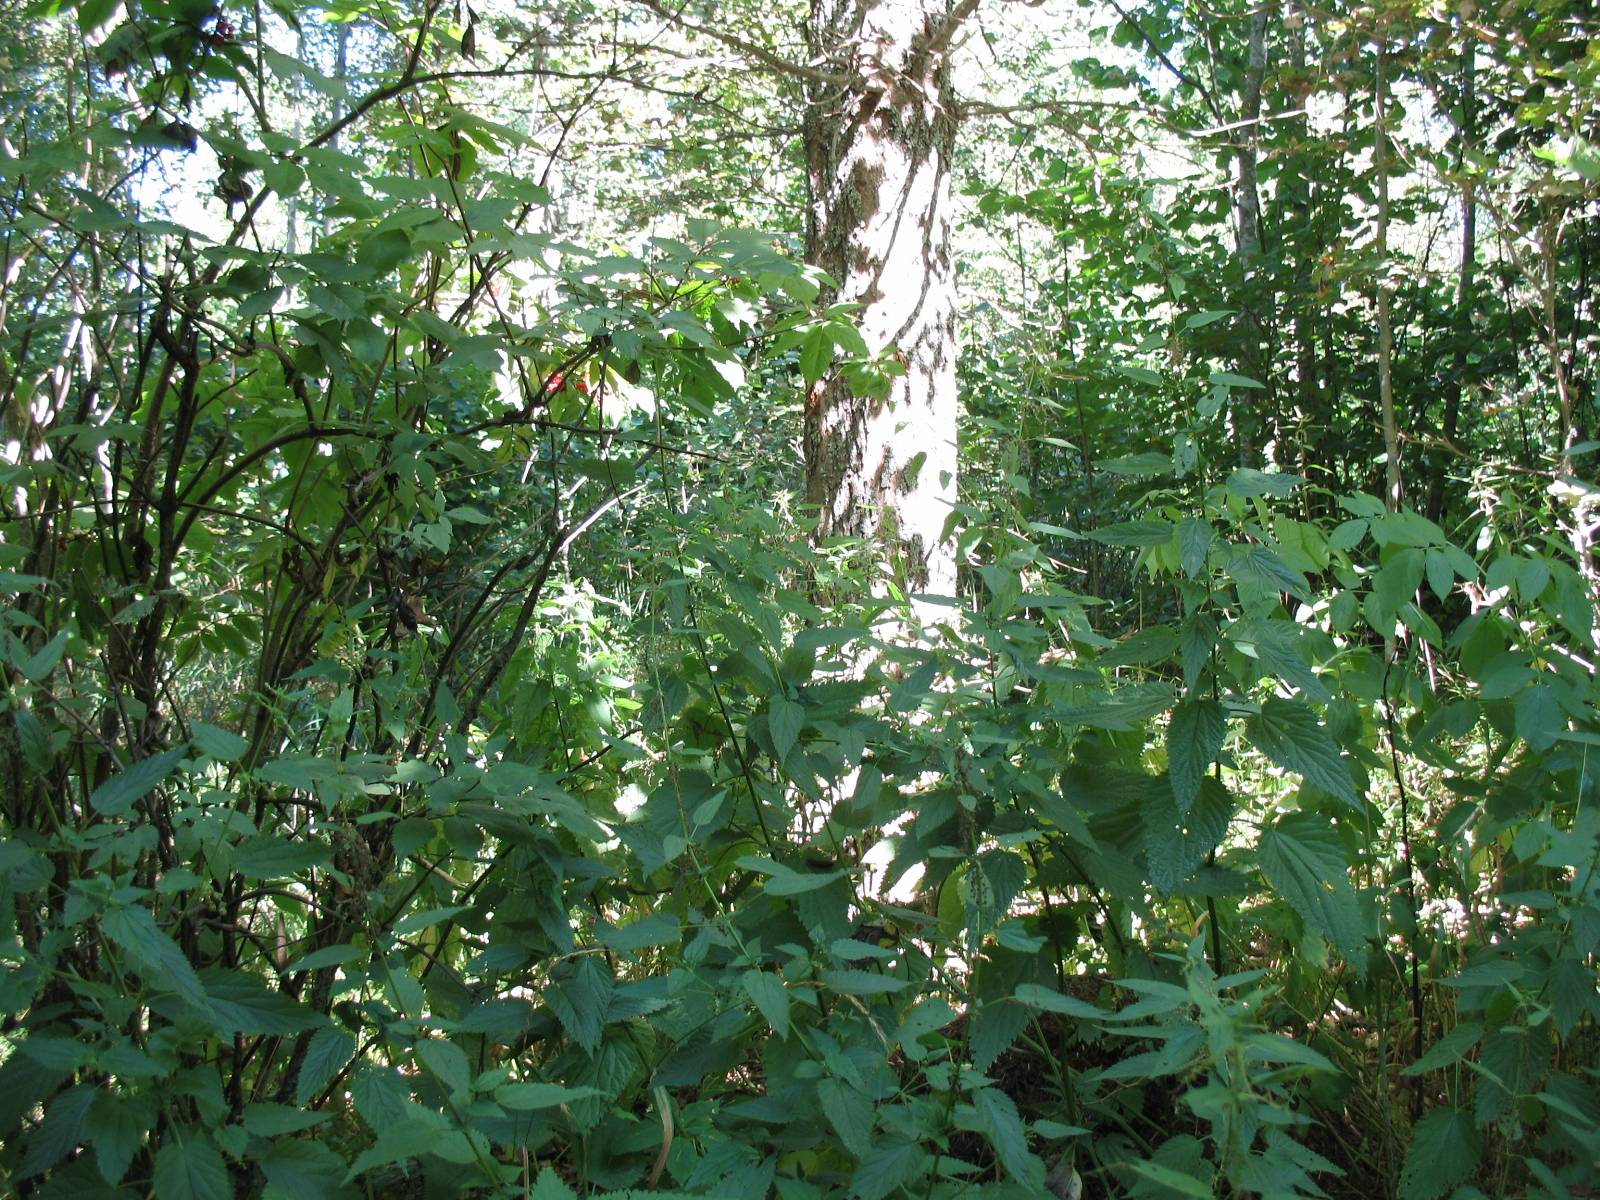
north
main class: Woodland
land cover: Broadleaved woodland
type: non-riverine alder, birch or aspen forest
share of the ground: 50 - 75 %
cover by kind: broadleaved forest trees 70 %, herbaceous plants 25 %, shrubs 5 %
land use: Forestry
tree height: > 5 m
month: August
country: LV
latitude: 56.5362
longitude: 25.6865
